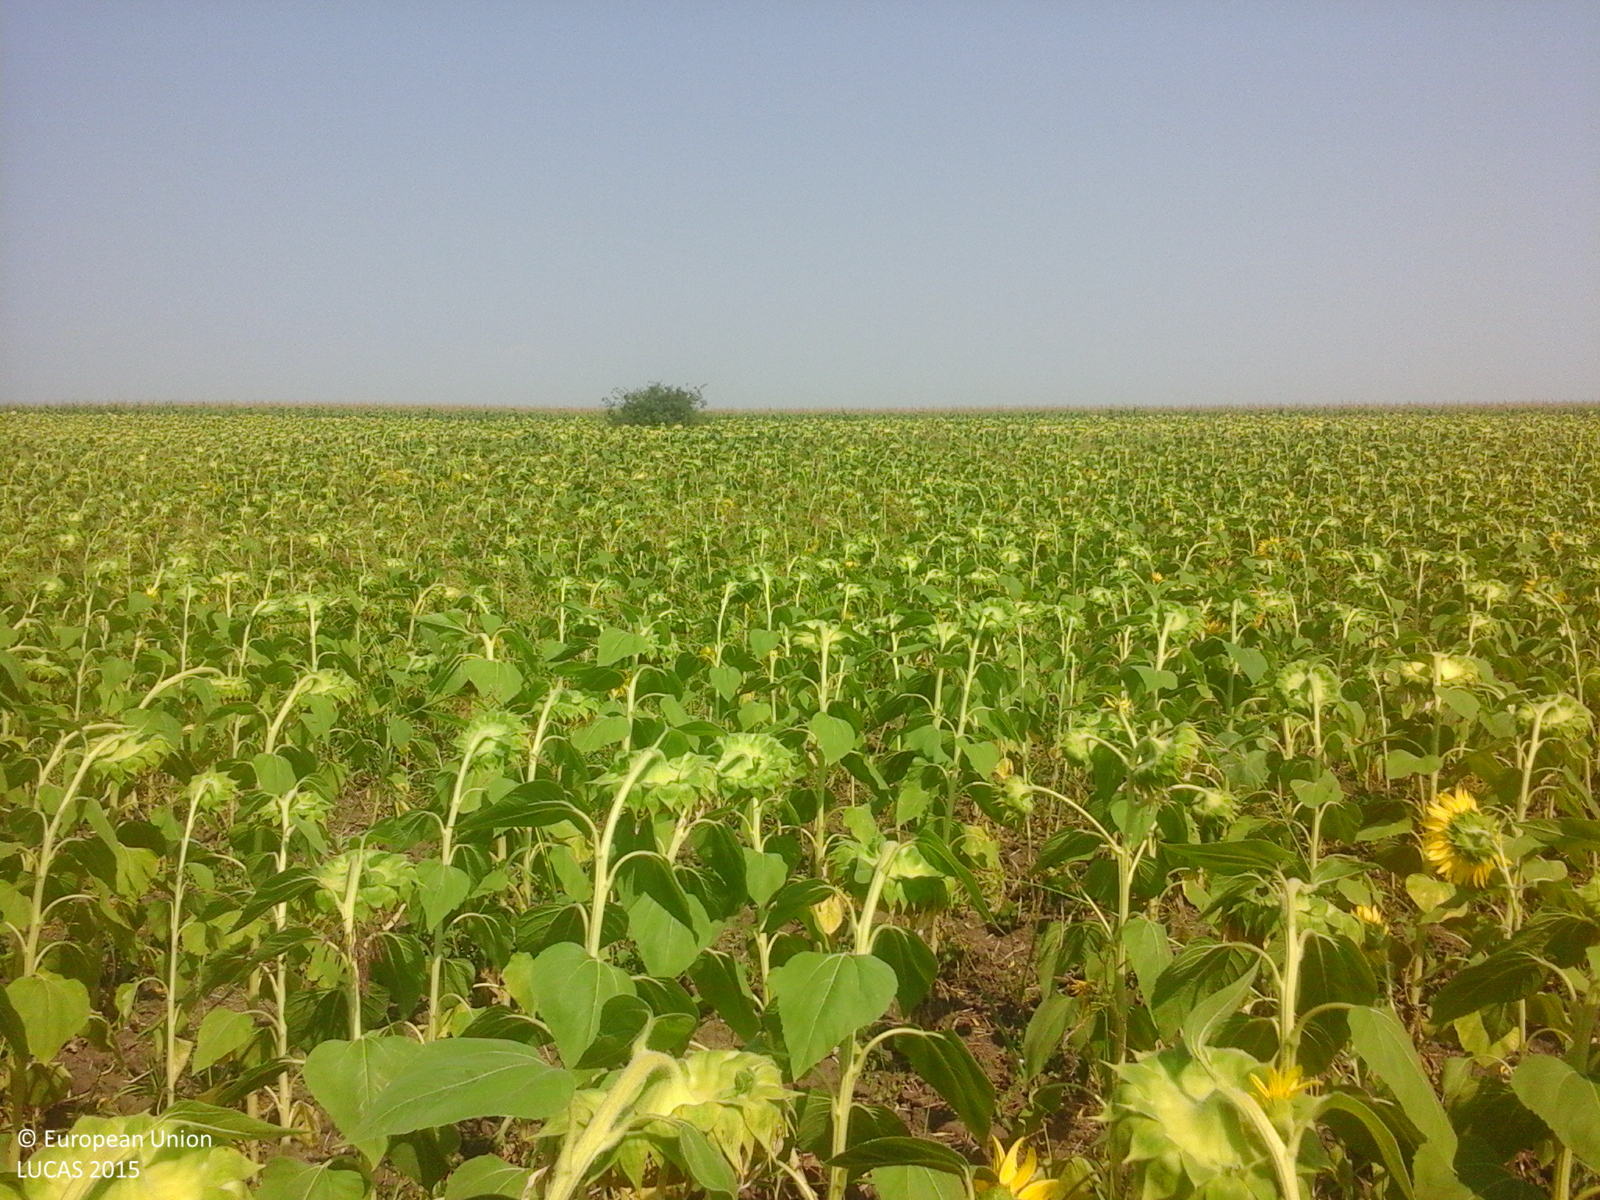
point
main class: Cropland
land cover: Sunflower
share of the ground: > 75 %
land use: Agriculture (excluding fallow land and kitchen gardens)
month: July
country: RO
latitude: 45.6259
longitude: 27.8529
